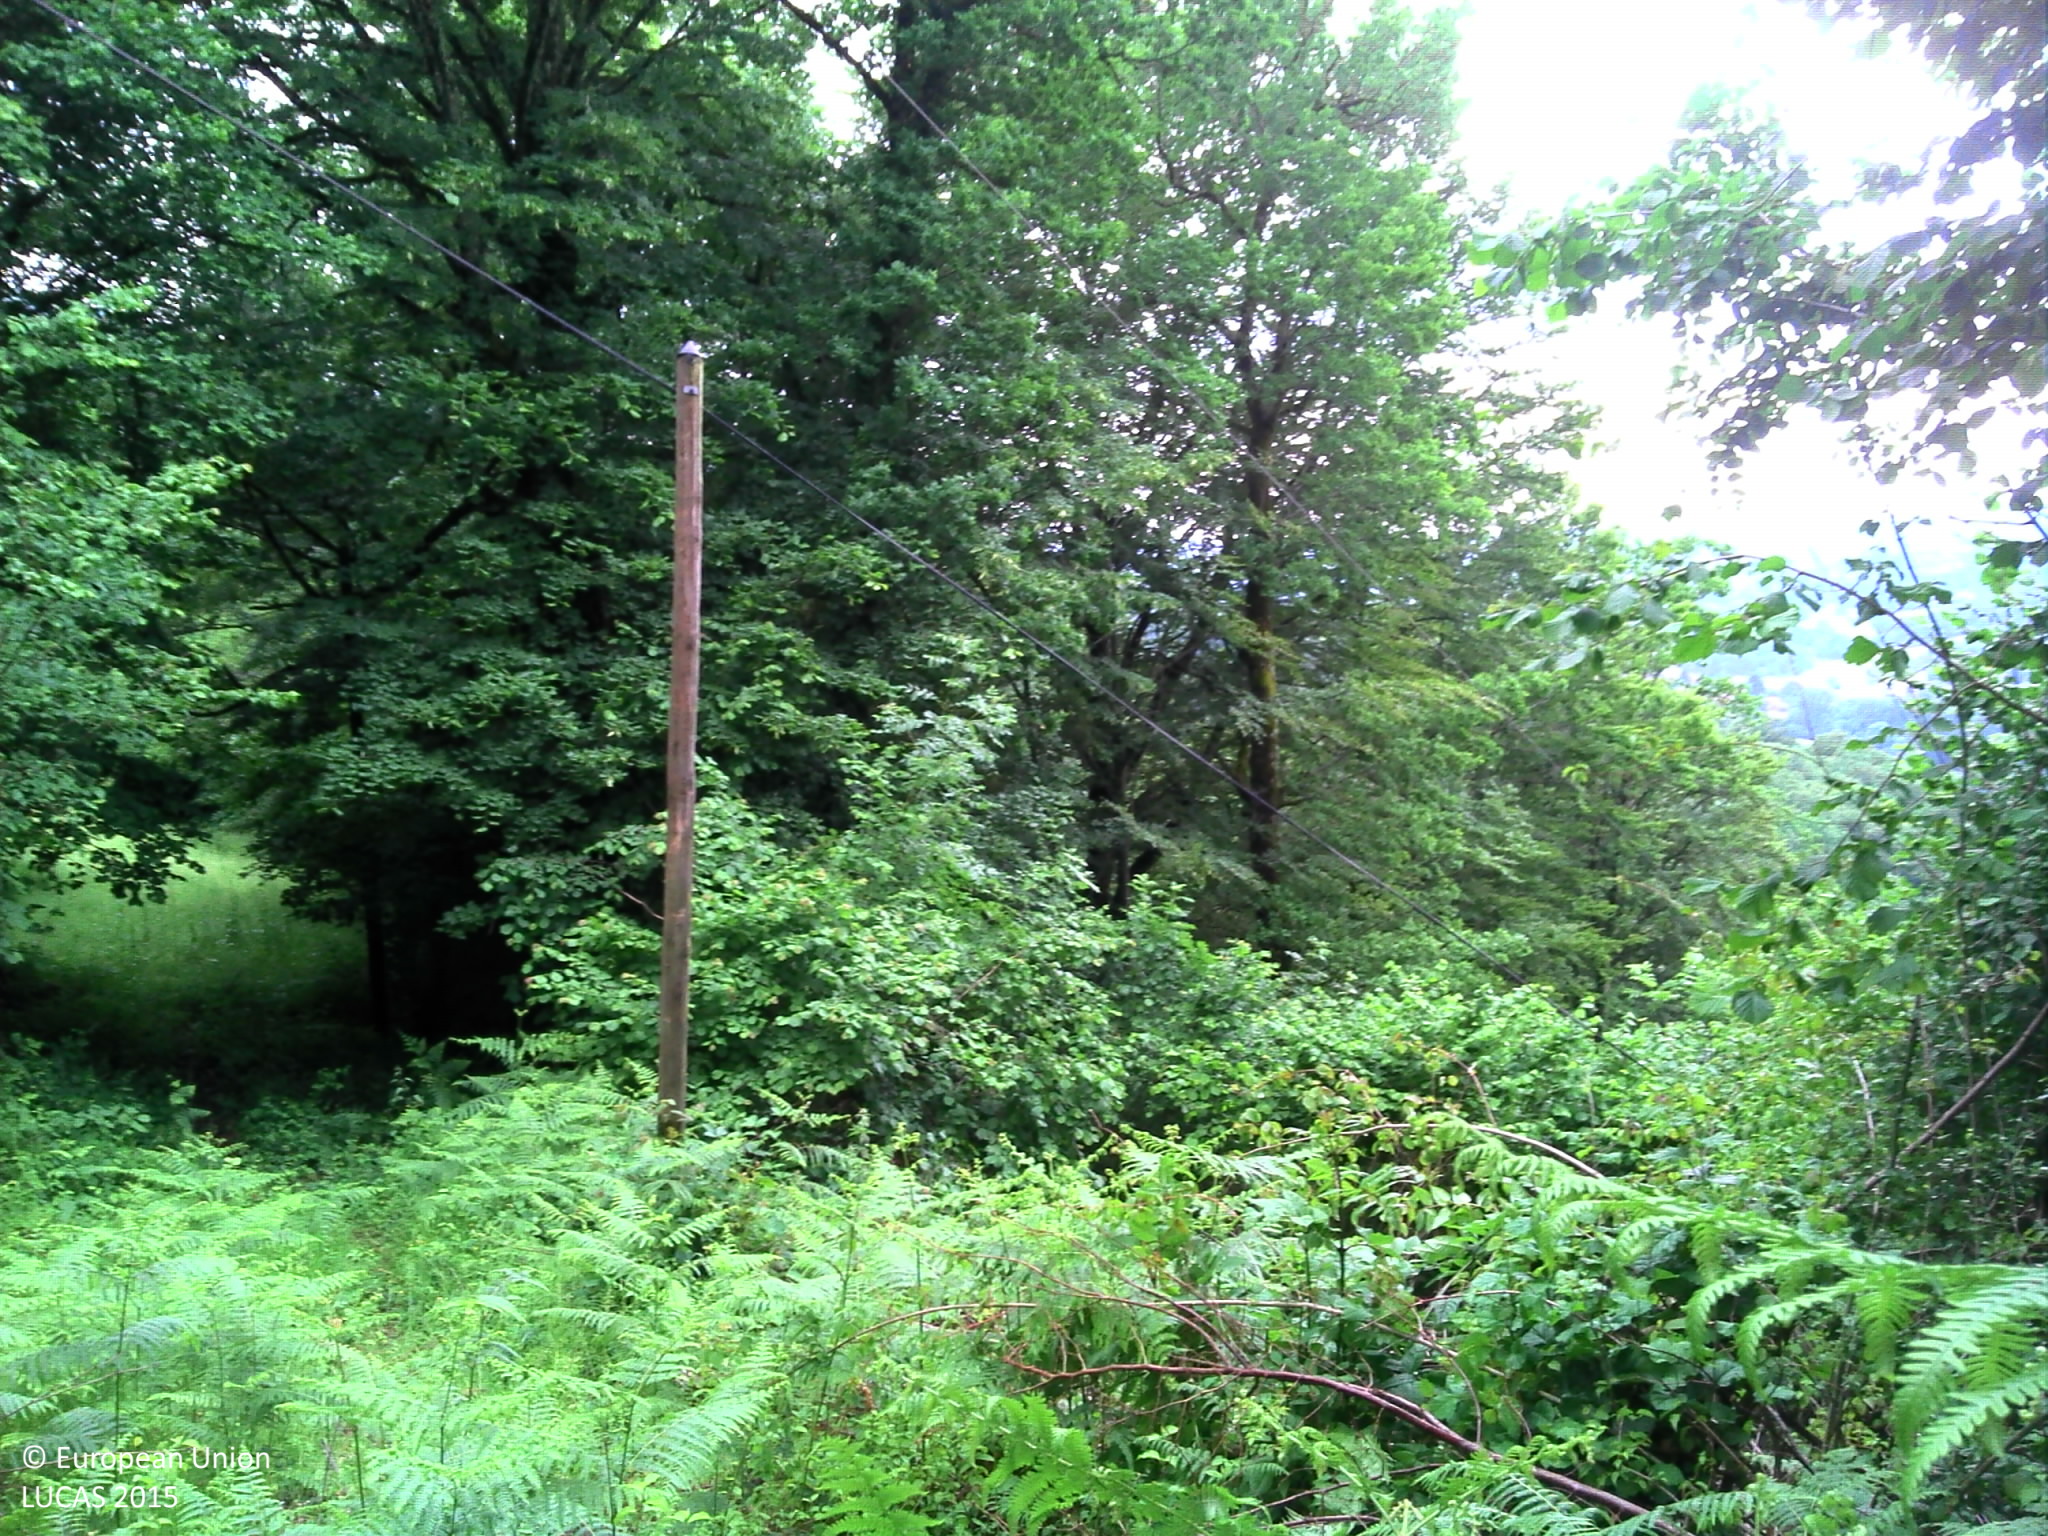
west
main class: Woodland
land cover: Broadleaved woodland
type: acidophilous oak and oak-birch forest
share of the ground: > 75 %
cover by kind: broadleaved forest trees 75 %, shrubs 20 %, herbaceous plants 5 %
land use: Semi-natural and natural areas not in use
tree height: > 5 m
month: June
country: FR
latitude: 45.0024
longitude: 2.5028
